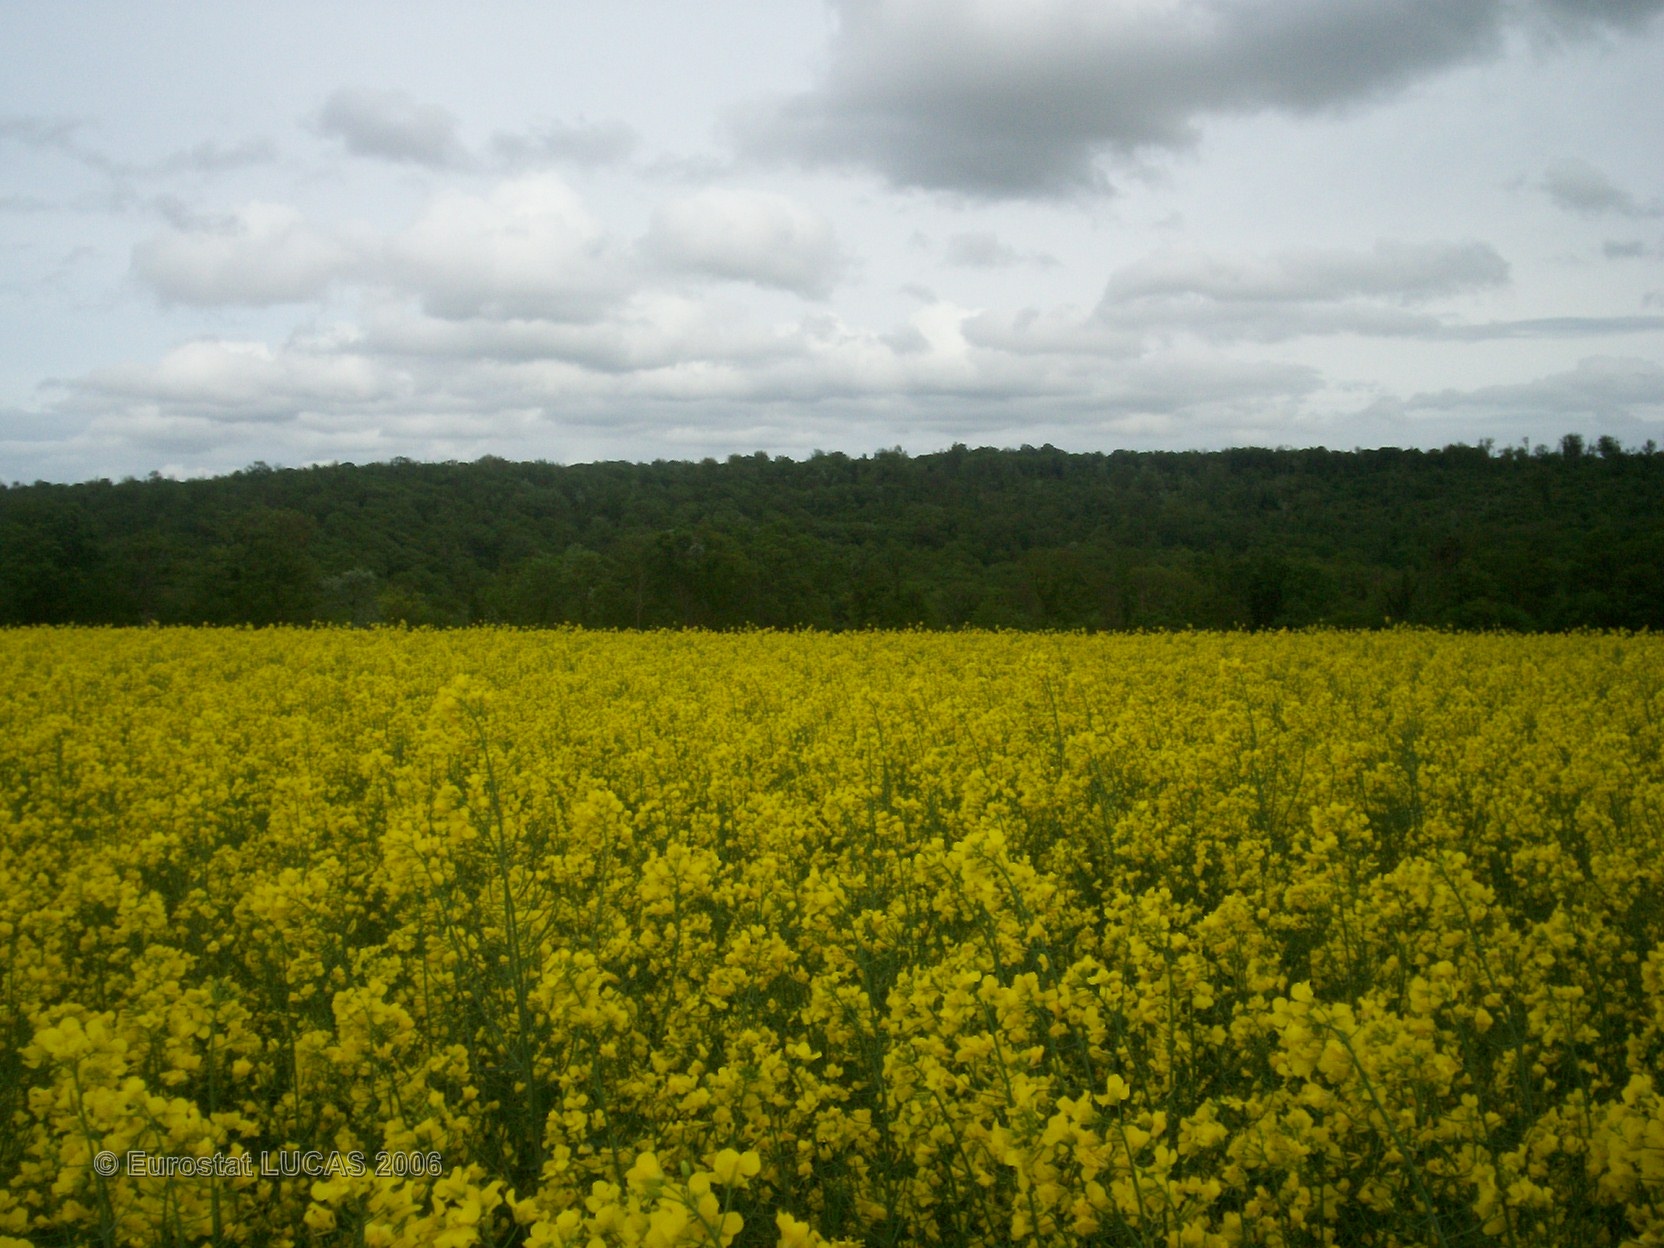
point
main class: Cropland
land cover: Rape and turnip rape
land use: Agriculture (excluding fallow land and kitchen gardens)
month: May
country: FR
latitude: 48.5824
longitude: 5.9738
